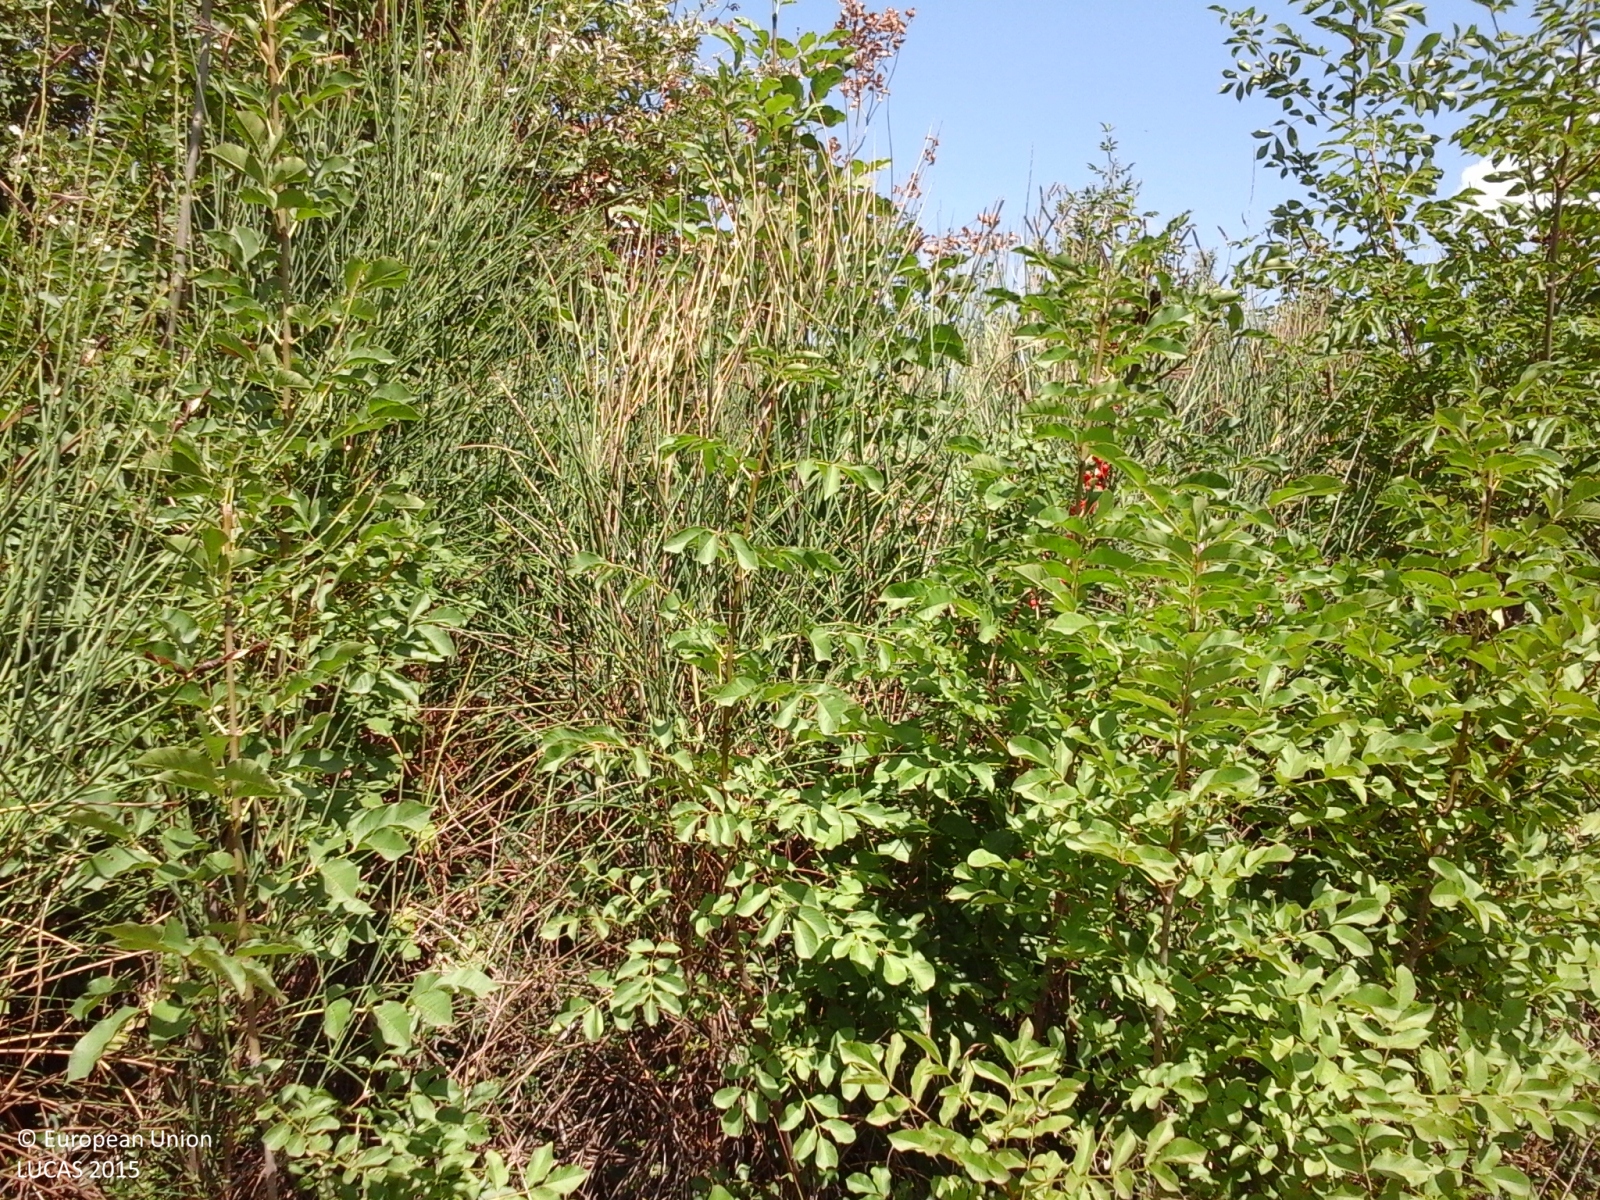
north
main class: Woodland
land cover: Broadleaved woodland
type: thermophilous deciduous forest
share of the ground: > 75 %
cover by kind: broadleaved forest trees 95 %, shrubs 5 %
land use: Forestry
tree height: > 5 m
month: August
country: IT
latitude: 41.8910
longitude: 12.8459
